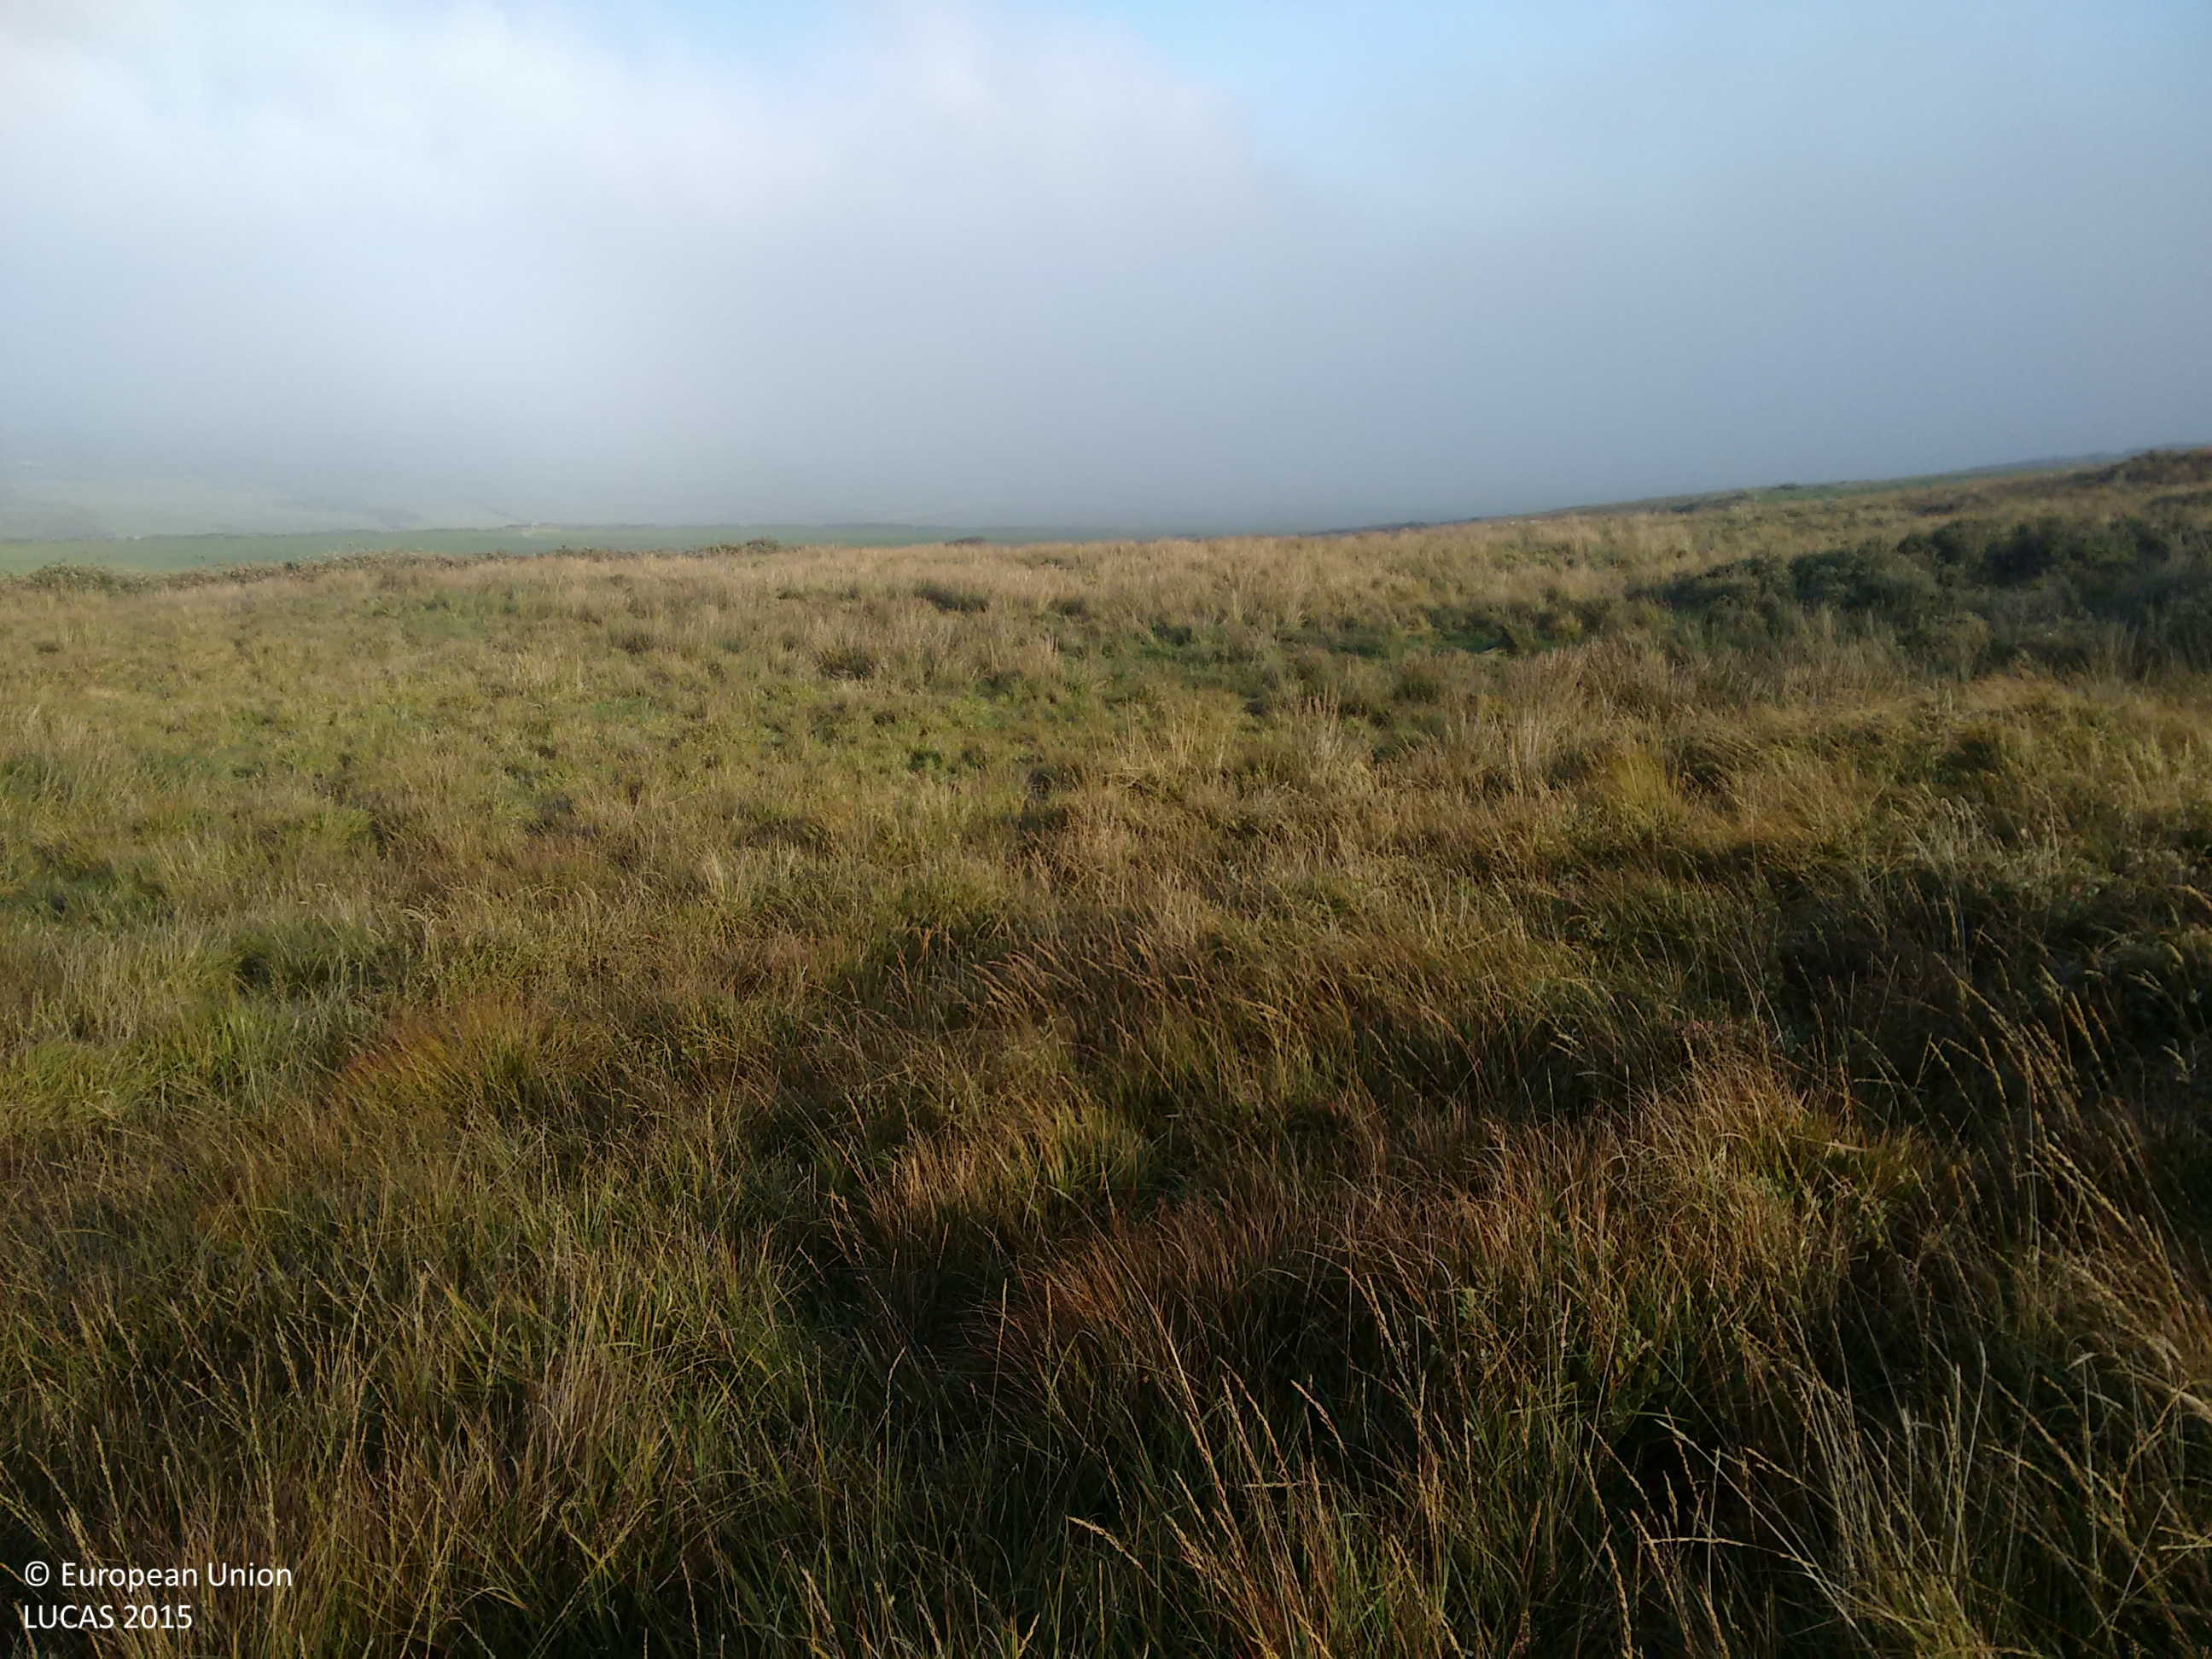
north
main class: Grassland
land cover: Grassland without tree/shrub cover
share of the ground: > 75 %
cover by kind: herbaceous plants 100 %
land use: Agriculture (excluding fallow land and kitchen gardens)
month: September
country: IE
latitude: 53.0878
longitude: -9.2912
